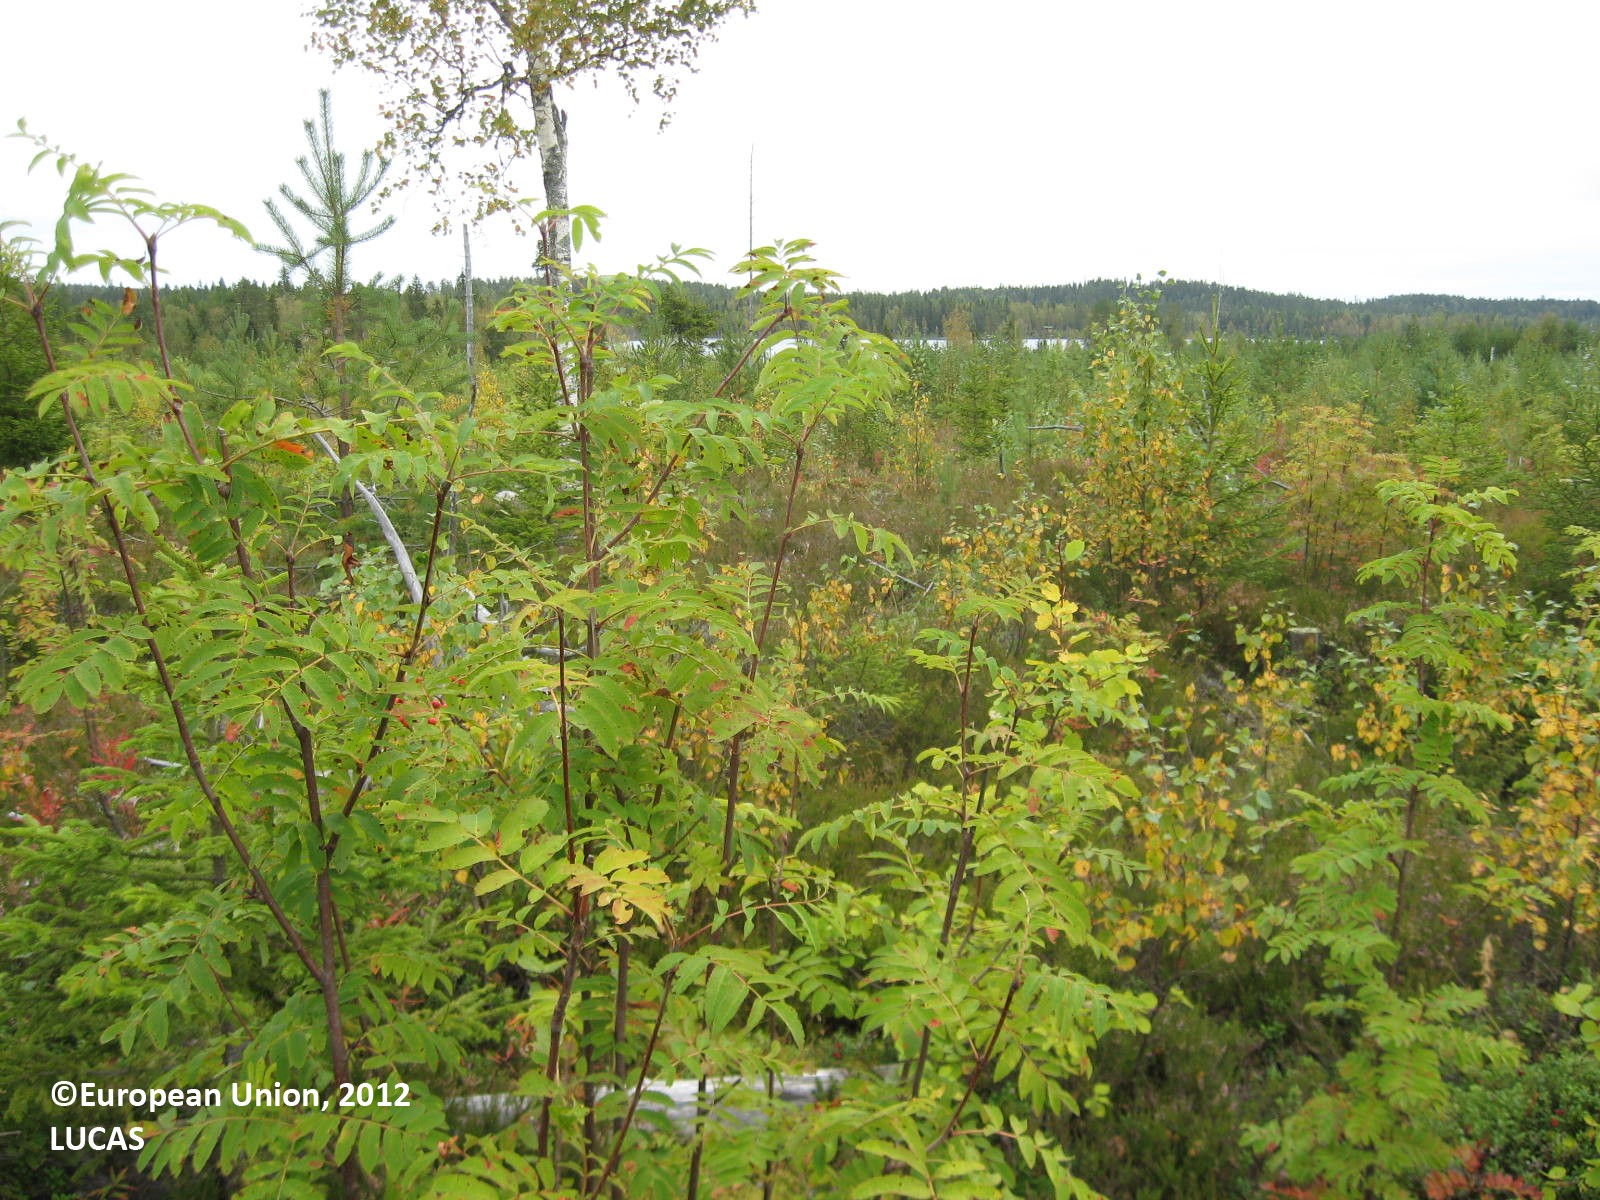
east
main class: Woodland
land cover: Other mixed woodland
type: boreal forest
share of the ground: 50 - 75 %
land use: Forestry
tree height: < 5 m
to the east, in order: Other mixed woodland; Ditches and canals; Other mixed woodland; Ditches and canals; Other mixed woodland; Inland marshes
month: August
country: FI
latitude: 63.8895
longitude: 29.4236
